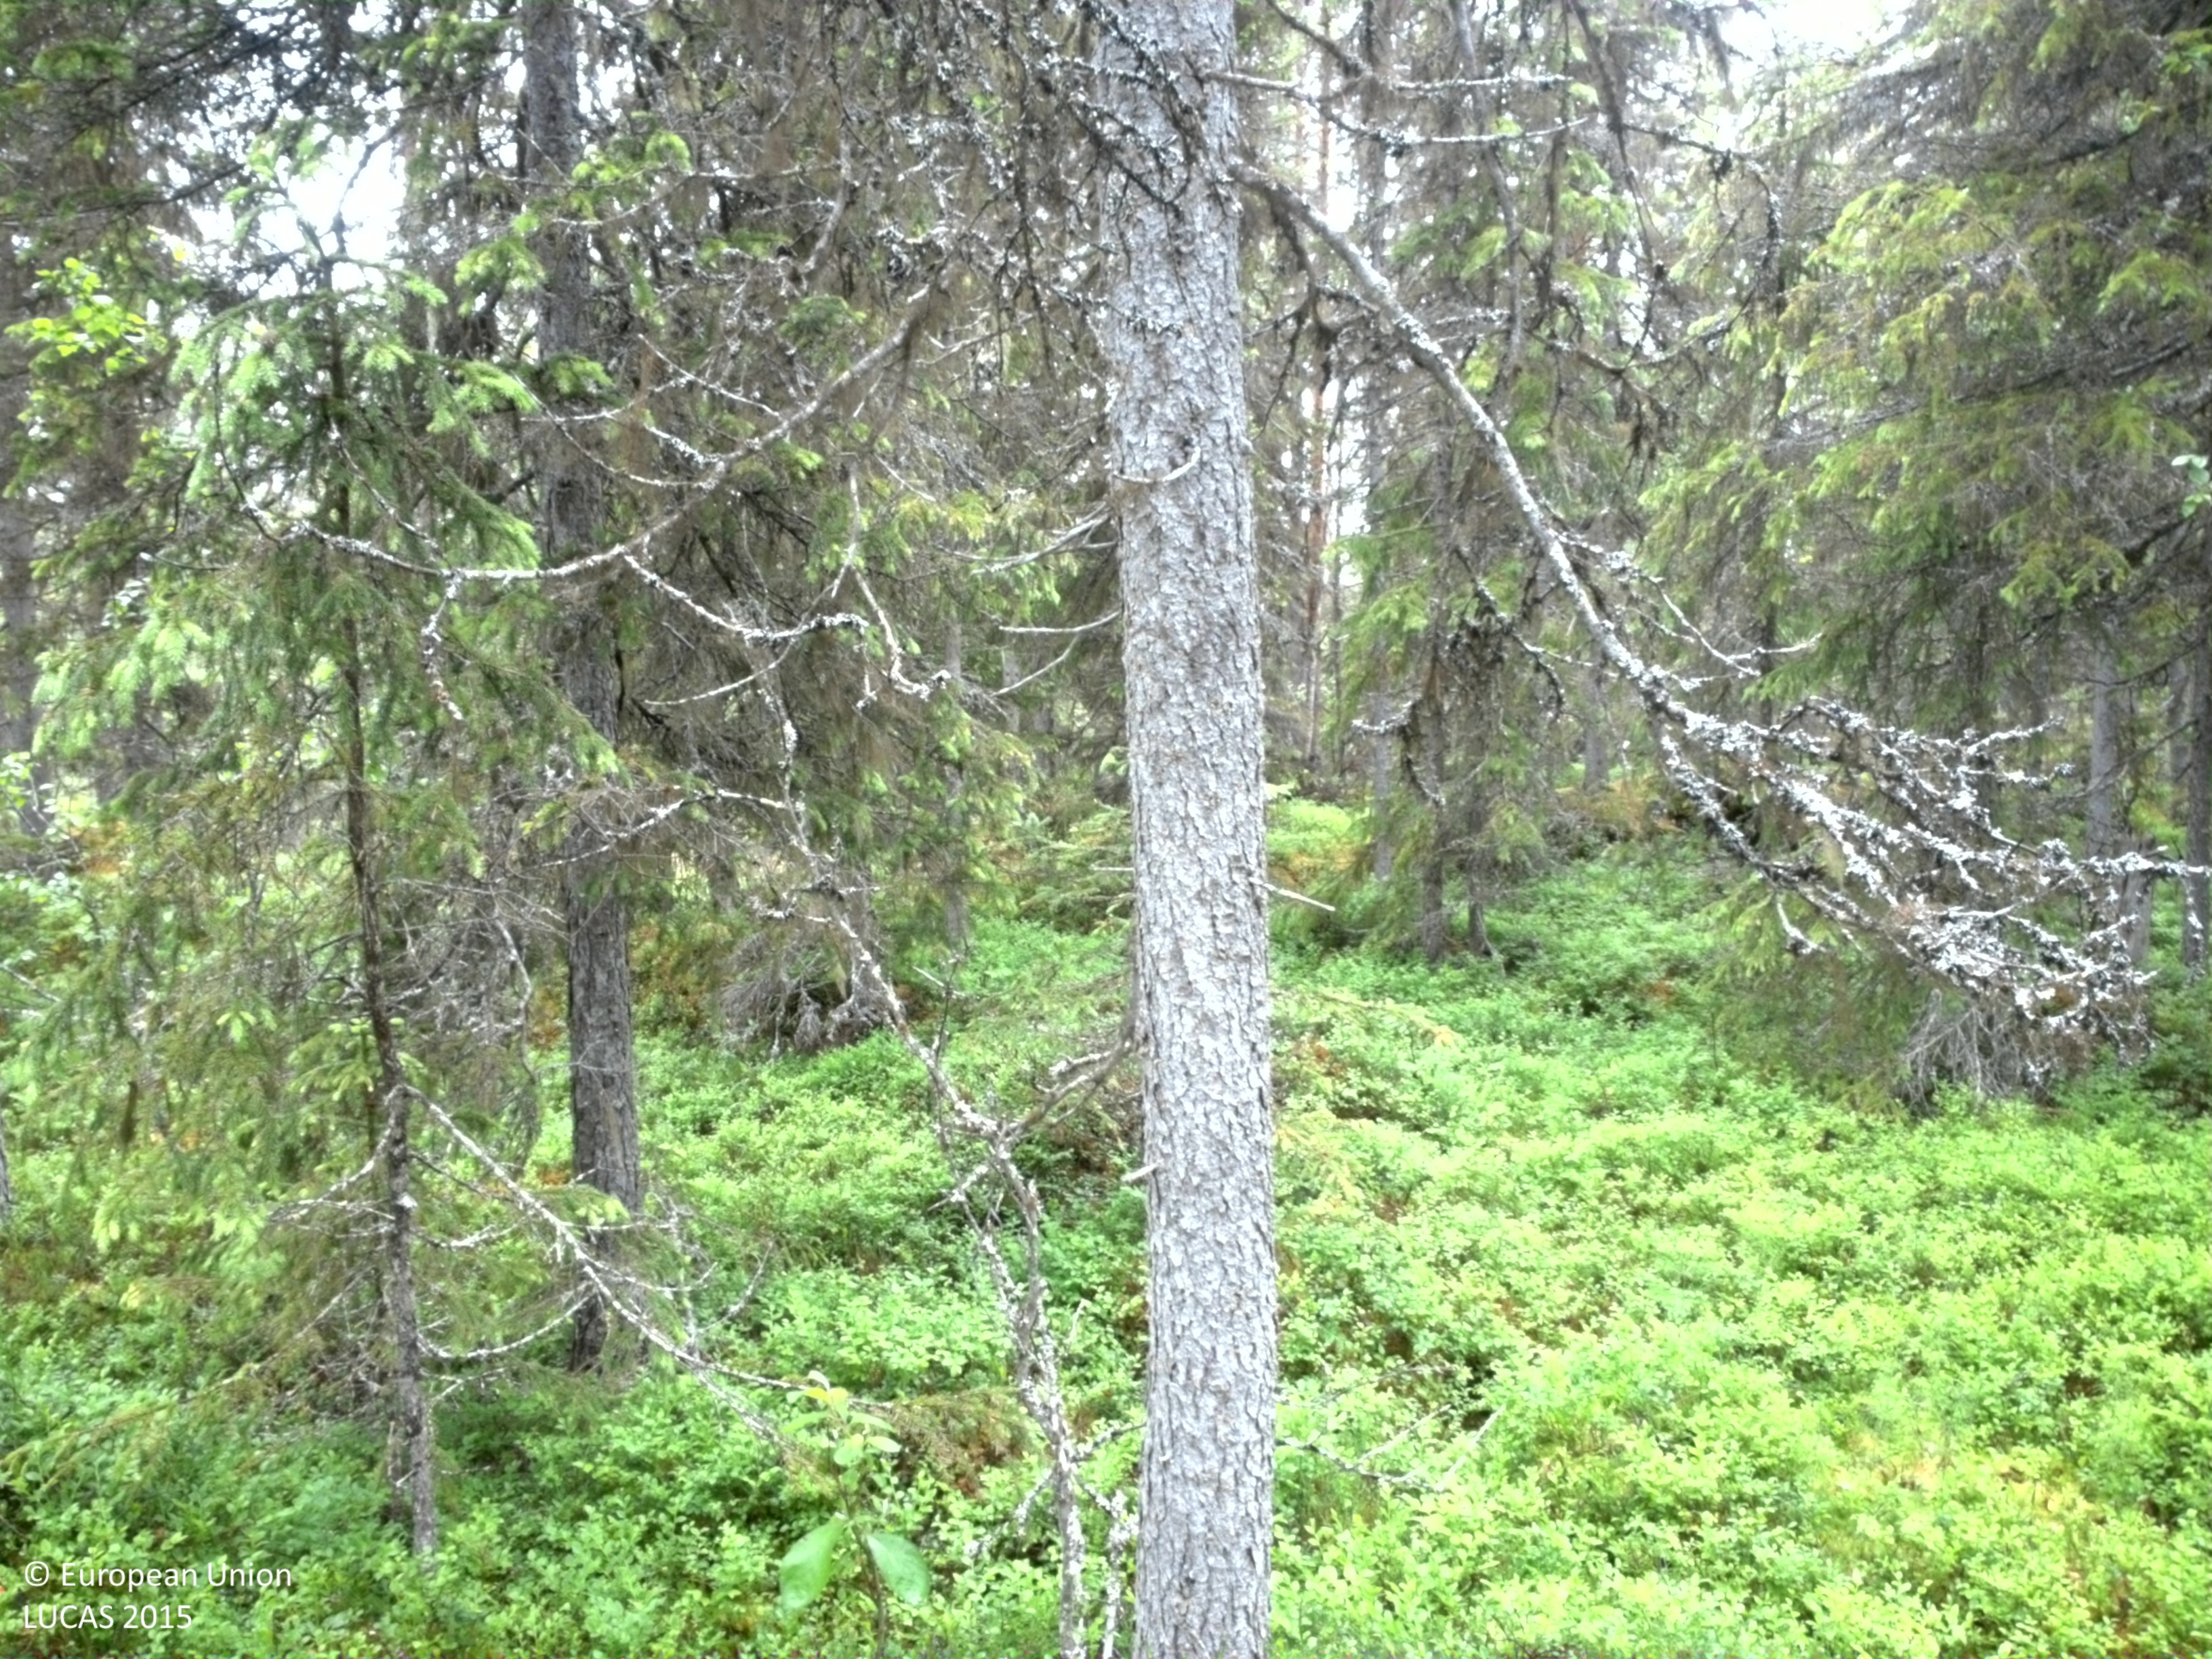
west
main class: Woodland
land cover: Other coniferous woodland
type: boreal forest
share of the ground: 25 - 50 %
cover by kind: coniferous forest trees 45 %, shrubs 40 %, lichens and mosses 10 %, broadleaved forest trees 5 %
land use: Forestry
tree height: > 5 m
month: July
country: SE
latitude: 64.6007
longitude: 18.2626
